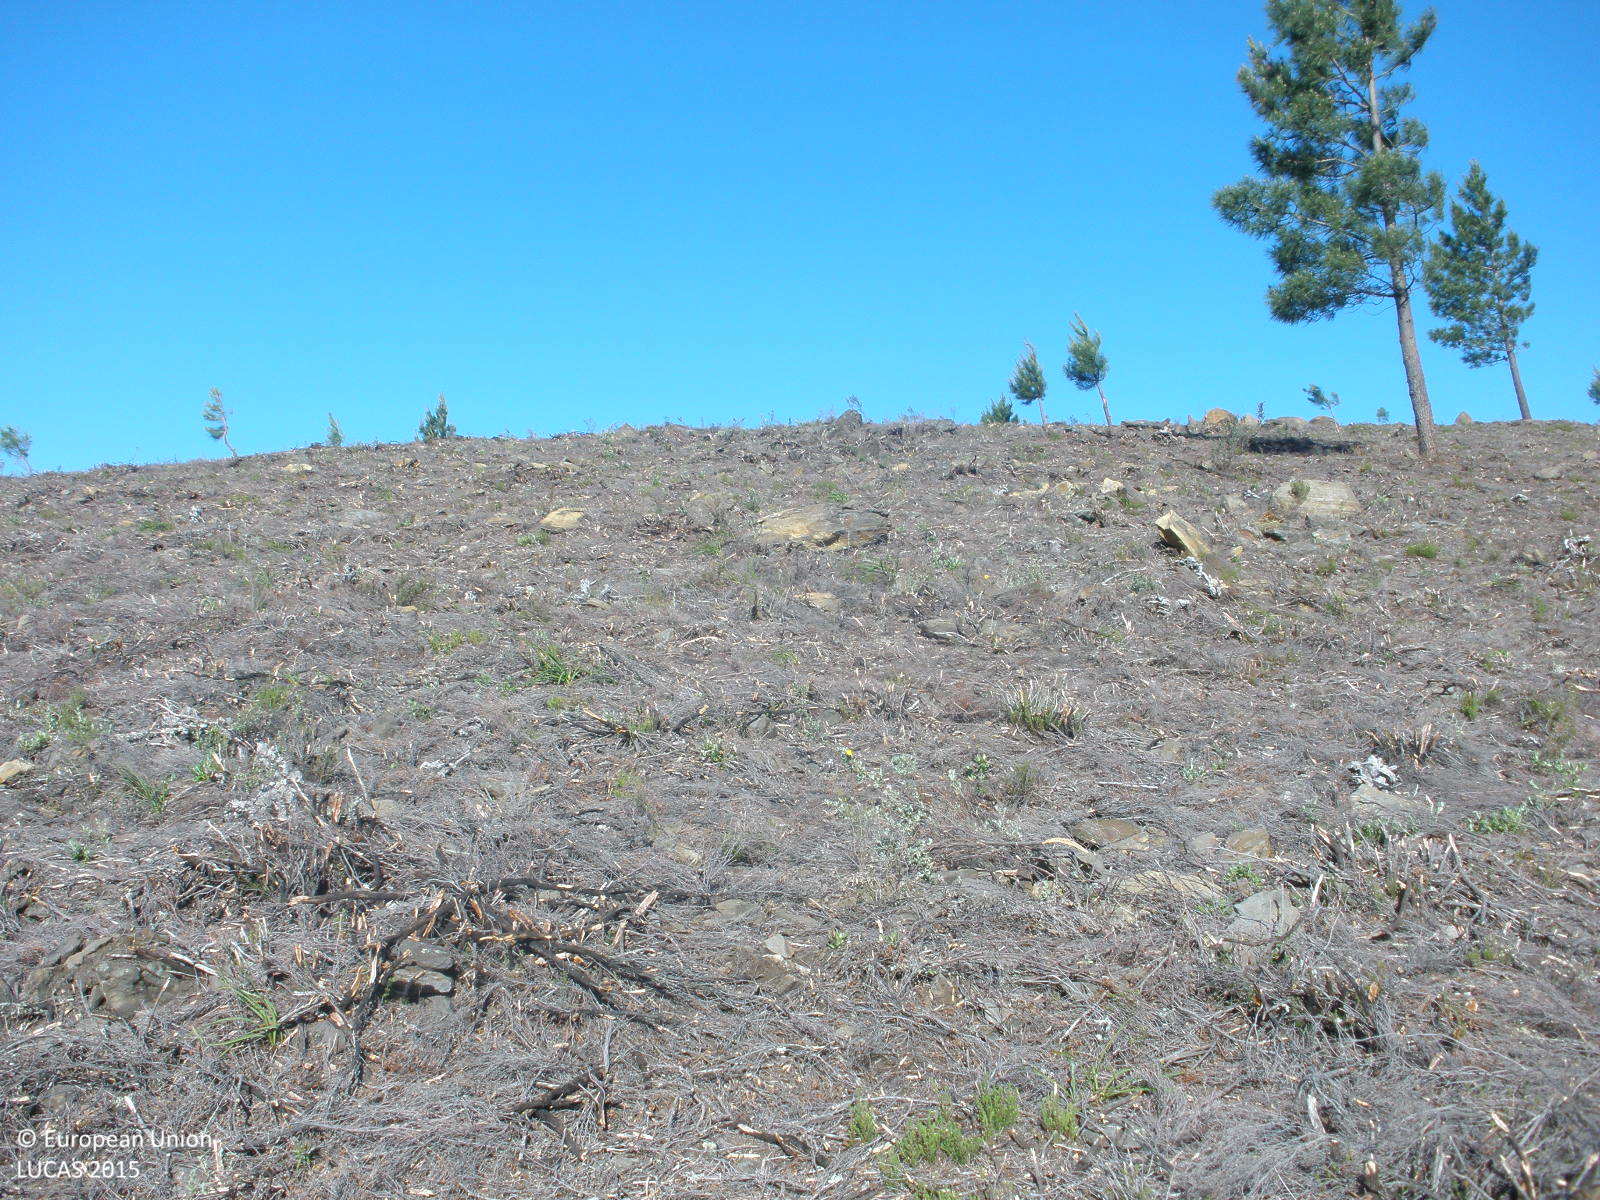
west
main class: Shrubland
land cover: Shrubland without tree cover
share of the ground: 50 - 75 %
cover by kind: consolidated bare surface 60 %, shrubs 40 %
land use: Forestry
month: May
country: ES
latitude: 40.2556
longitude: -6.6288
